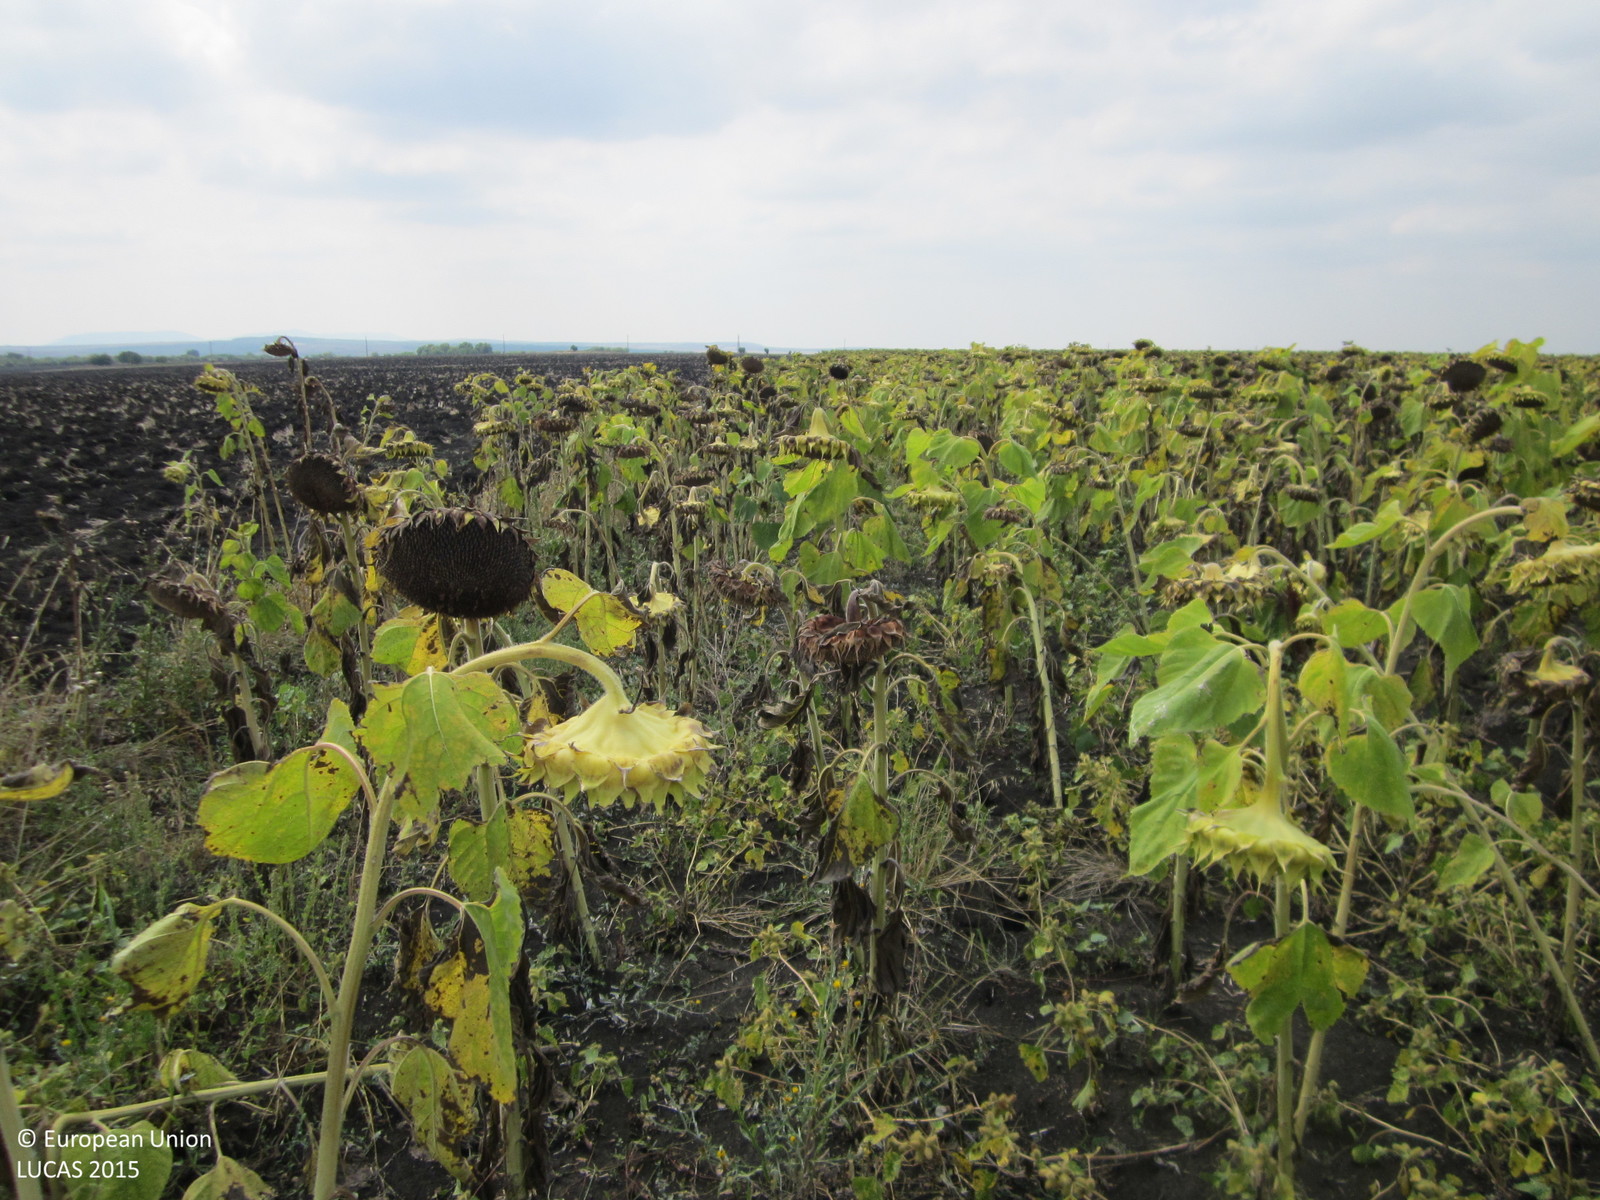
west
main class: Cropland
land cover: Sunflower
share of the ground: > 75 %
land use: Agriculture (excluding fallow land and kitchen gardens)
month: August
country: BG
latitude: 42.5304
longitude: 26.8908
